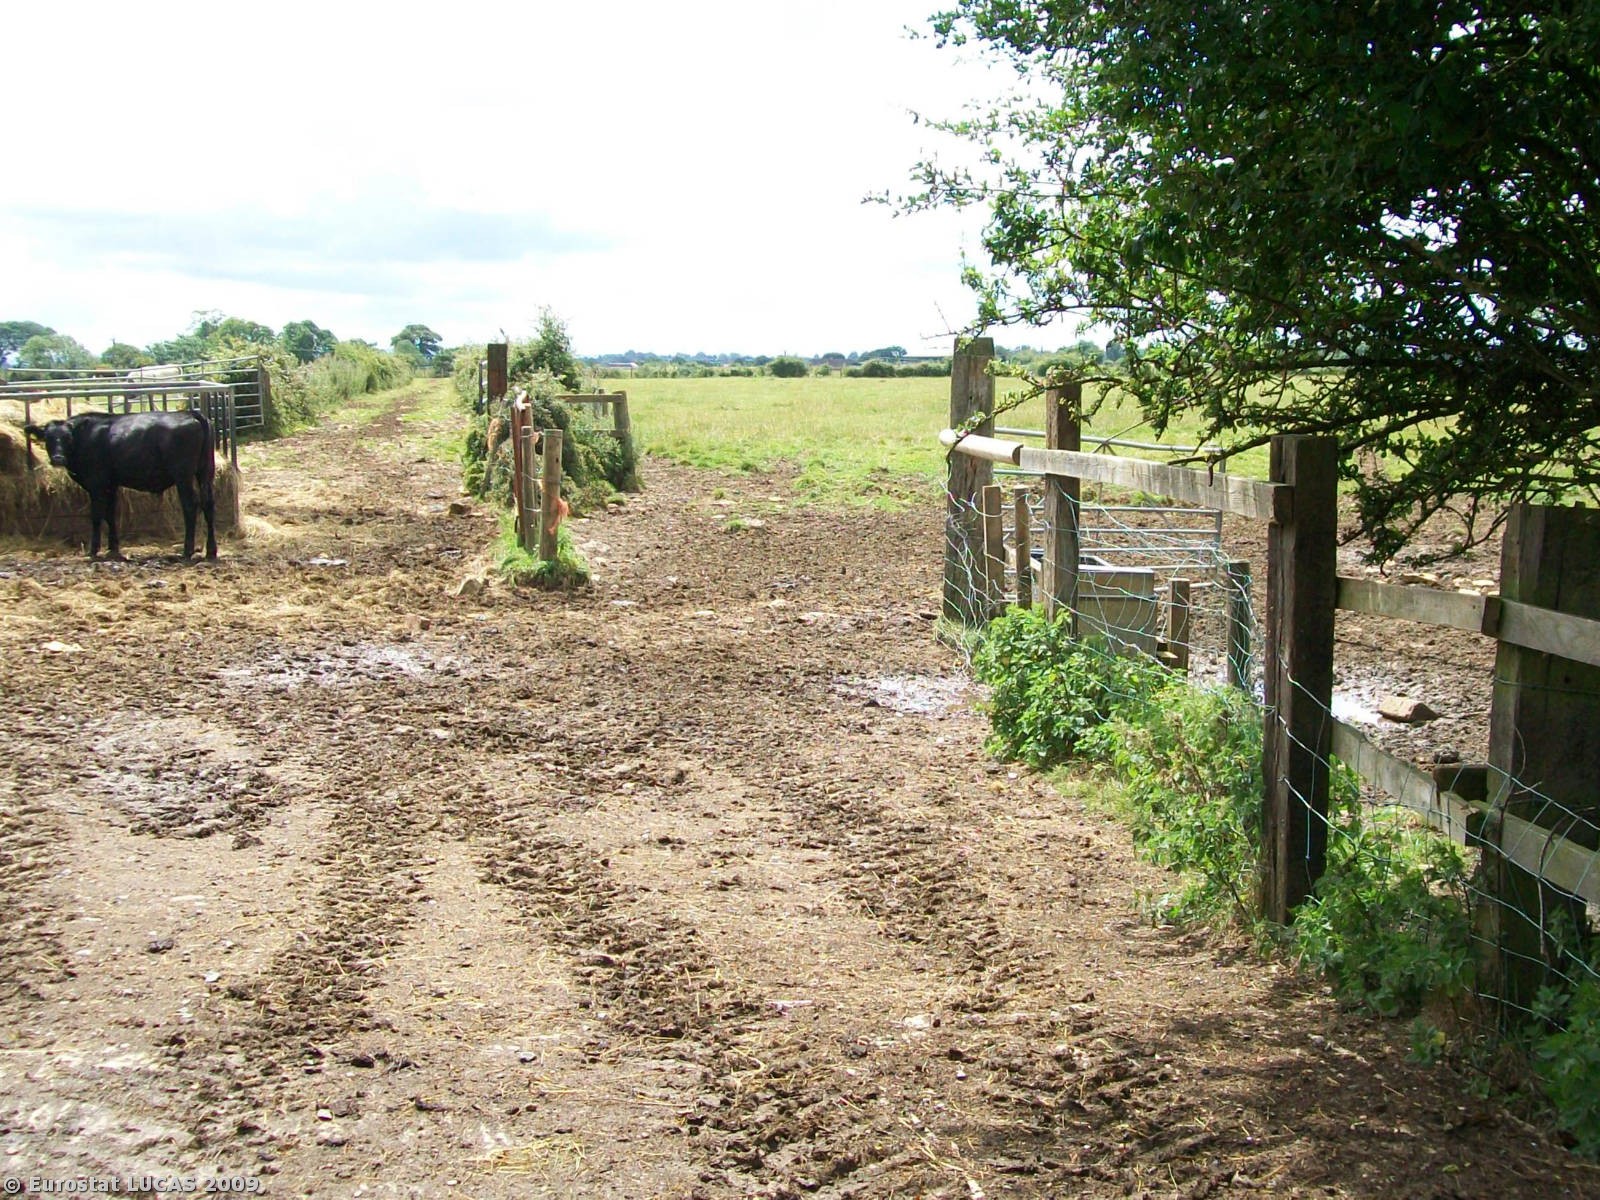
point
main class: Grassland
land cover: Grassland without tree/shrub cover
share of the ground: > 75 %
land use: Agriculture (excluding fallow land and kitchen gardens)
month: July
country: GB
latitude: 51.3959
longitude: -2.2358
